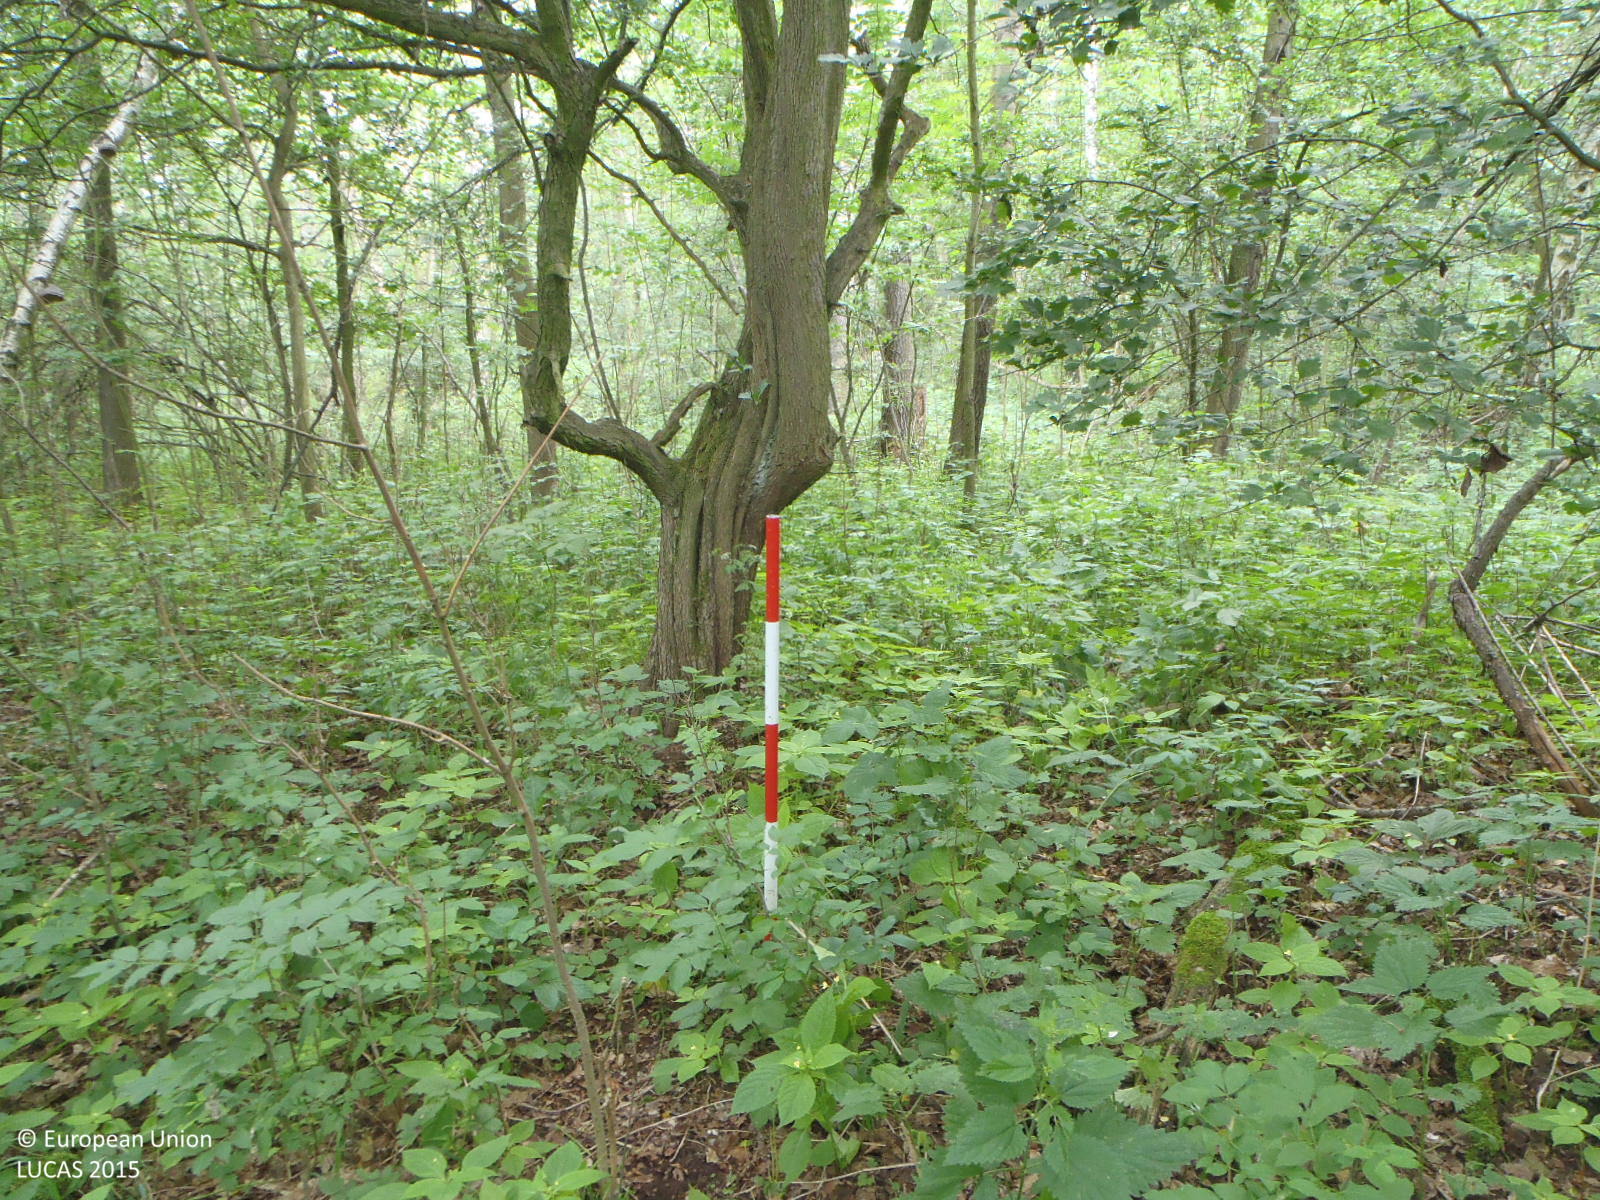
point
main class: Woodland
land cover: Broadleaved woodland
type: mesophytic deciduous forest
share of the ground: > 75 %
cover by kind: broadleaved forest trees 90 %, shrubs 5 %, herbaceous plants 5 %
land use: Forestry
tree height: > 5 m
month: June
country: CZ
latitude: 50.4983
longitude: 13.8213
